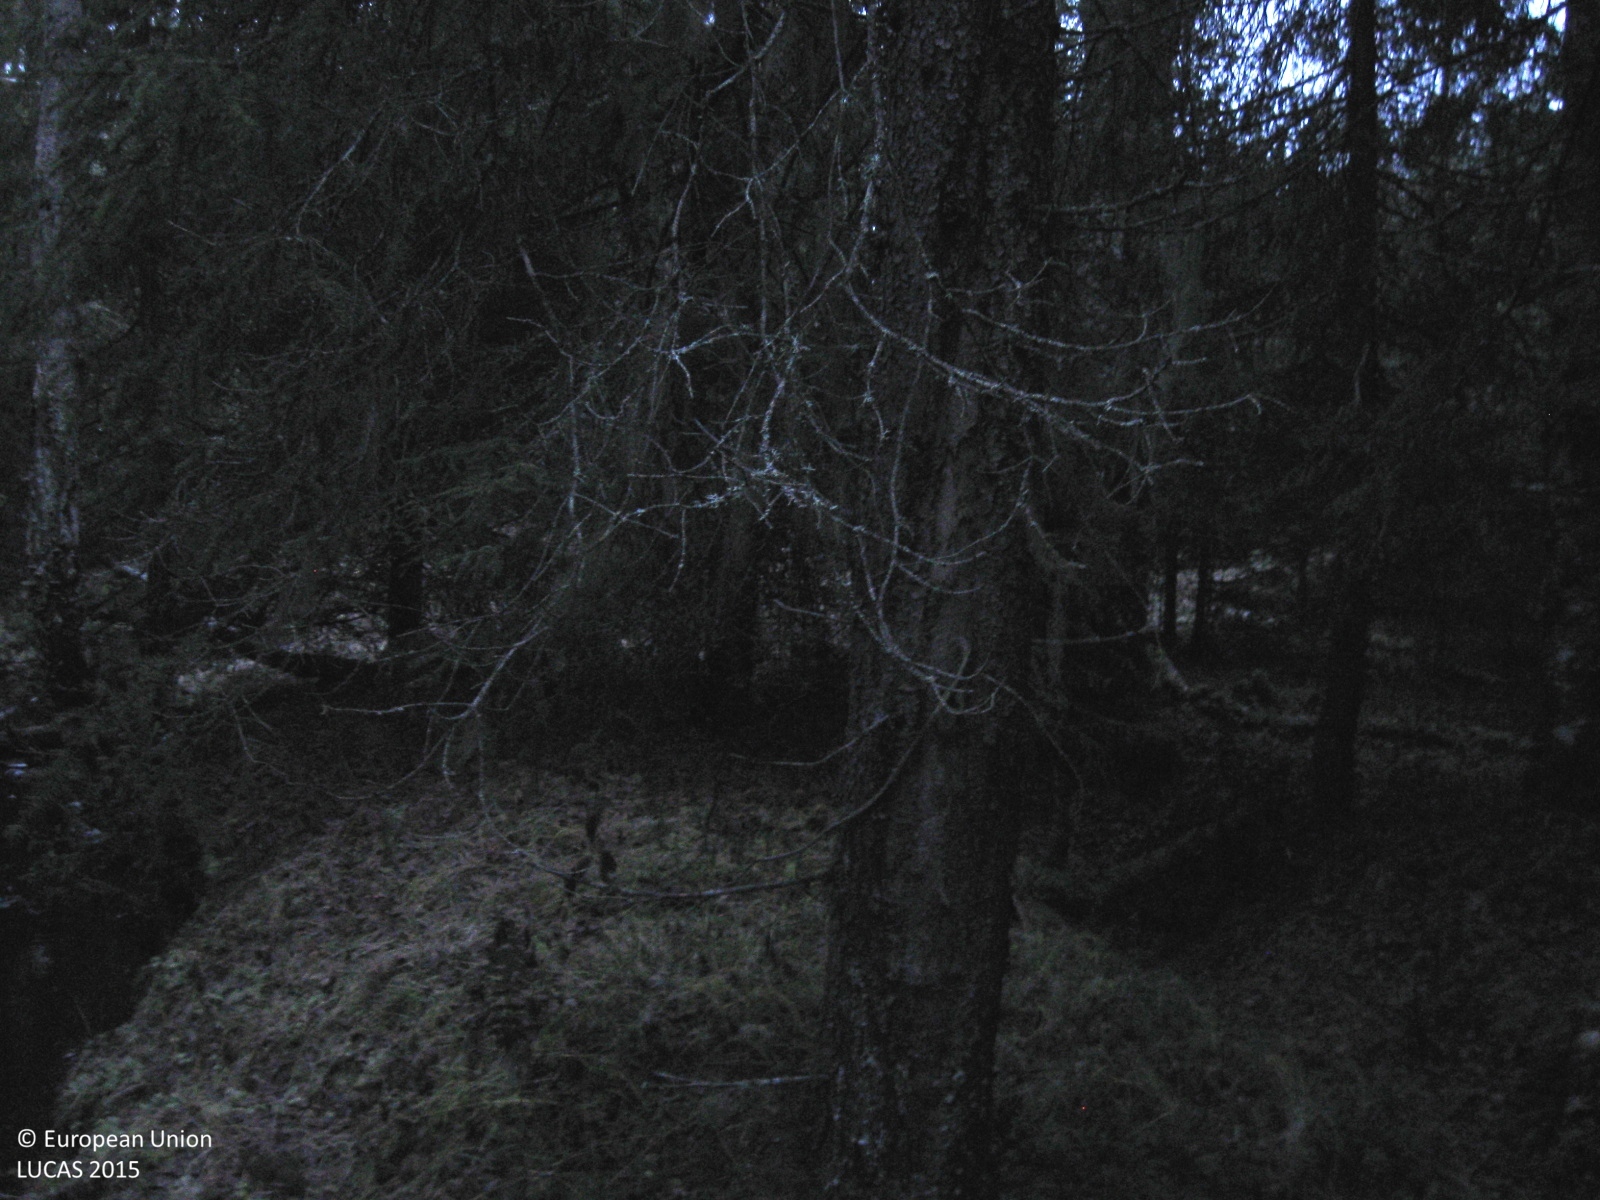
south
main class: Woodland
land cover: Spruce dominated mixed woodland
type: boreal forest
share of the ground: > 75 %
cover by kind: coniferous forest trees 50 %, broadleaved forest trees 25 %, herbaceous plants 10 %, shrubs 5 %, lichens and mosses 5 %
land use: Forestry
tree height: > 5 m
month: October
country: SE
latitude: 66.3281
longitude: 21.4143
